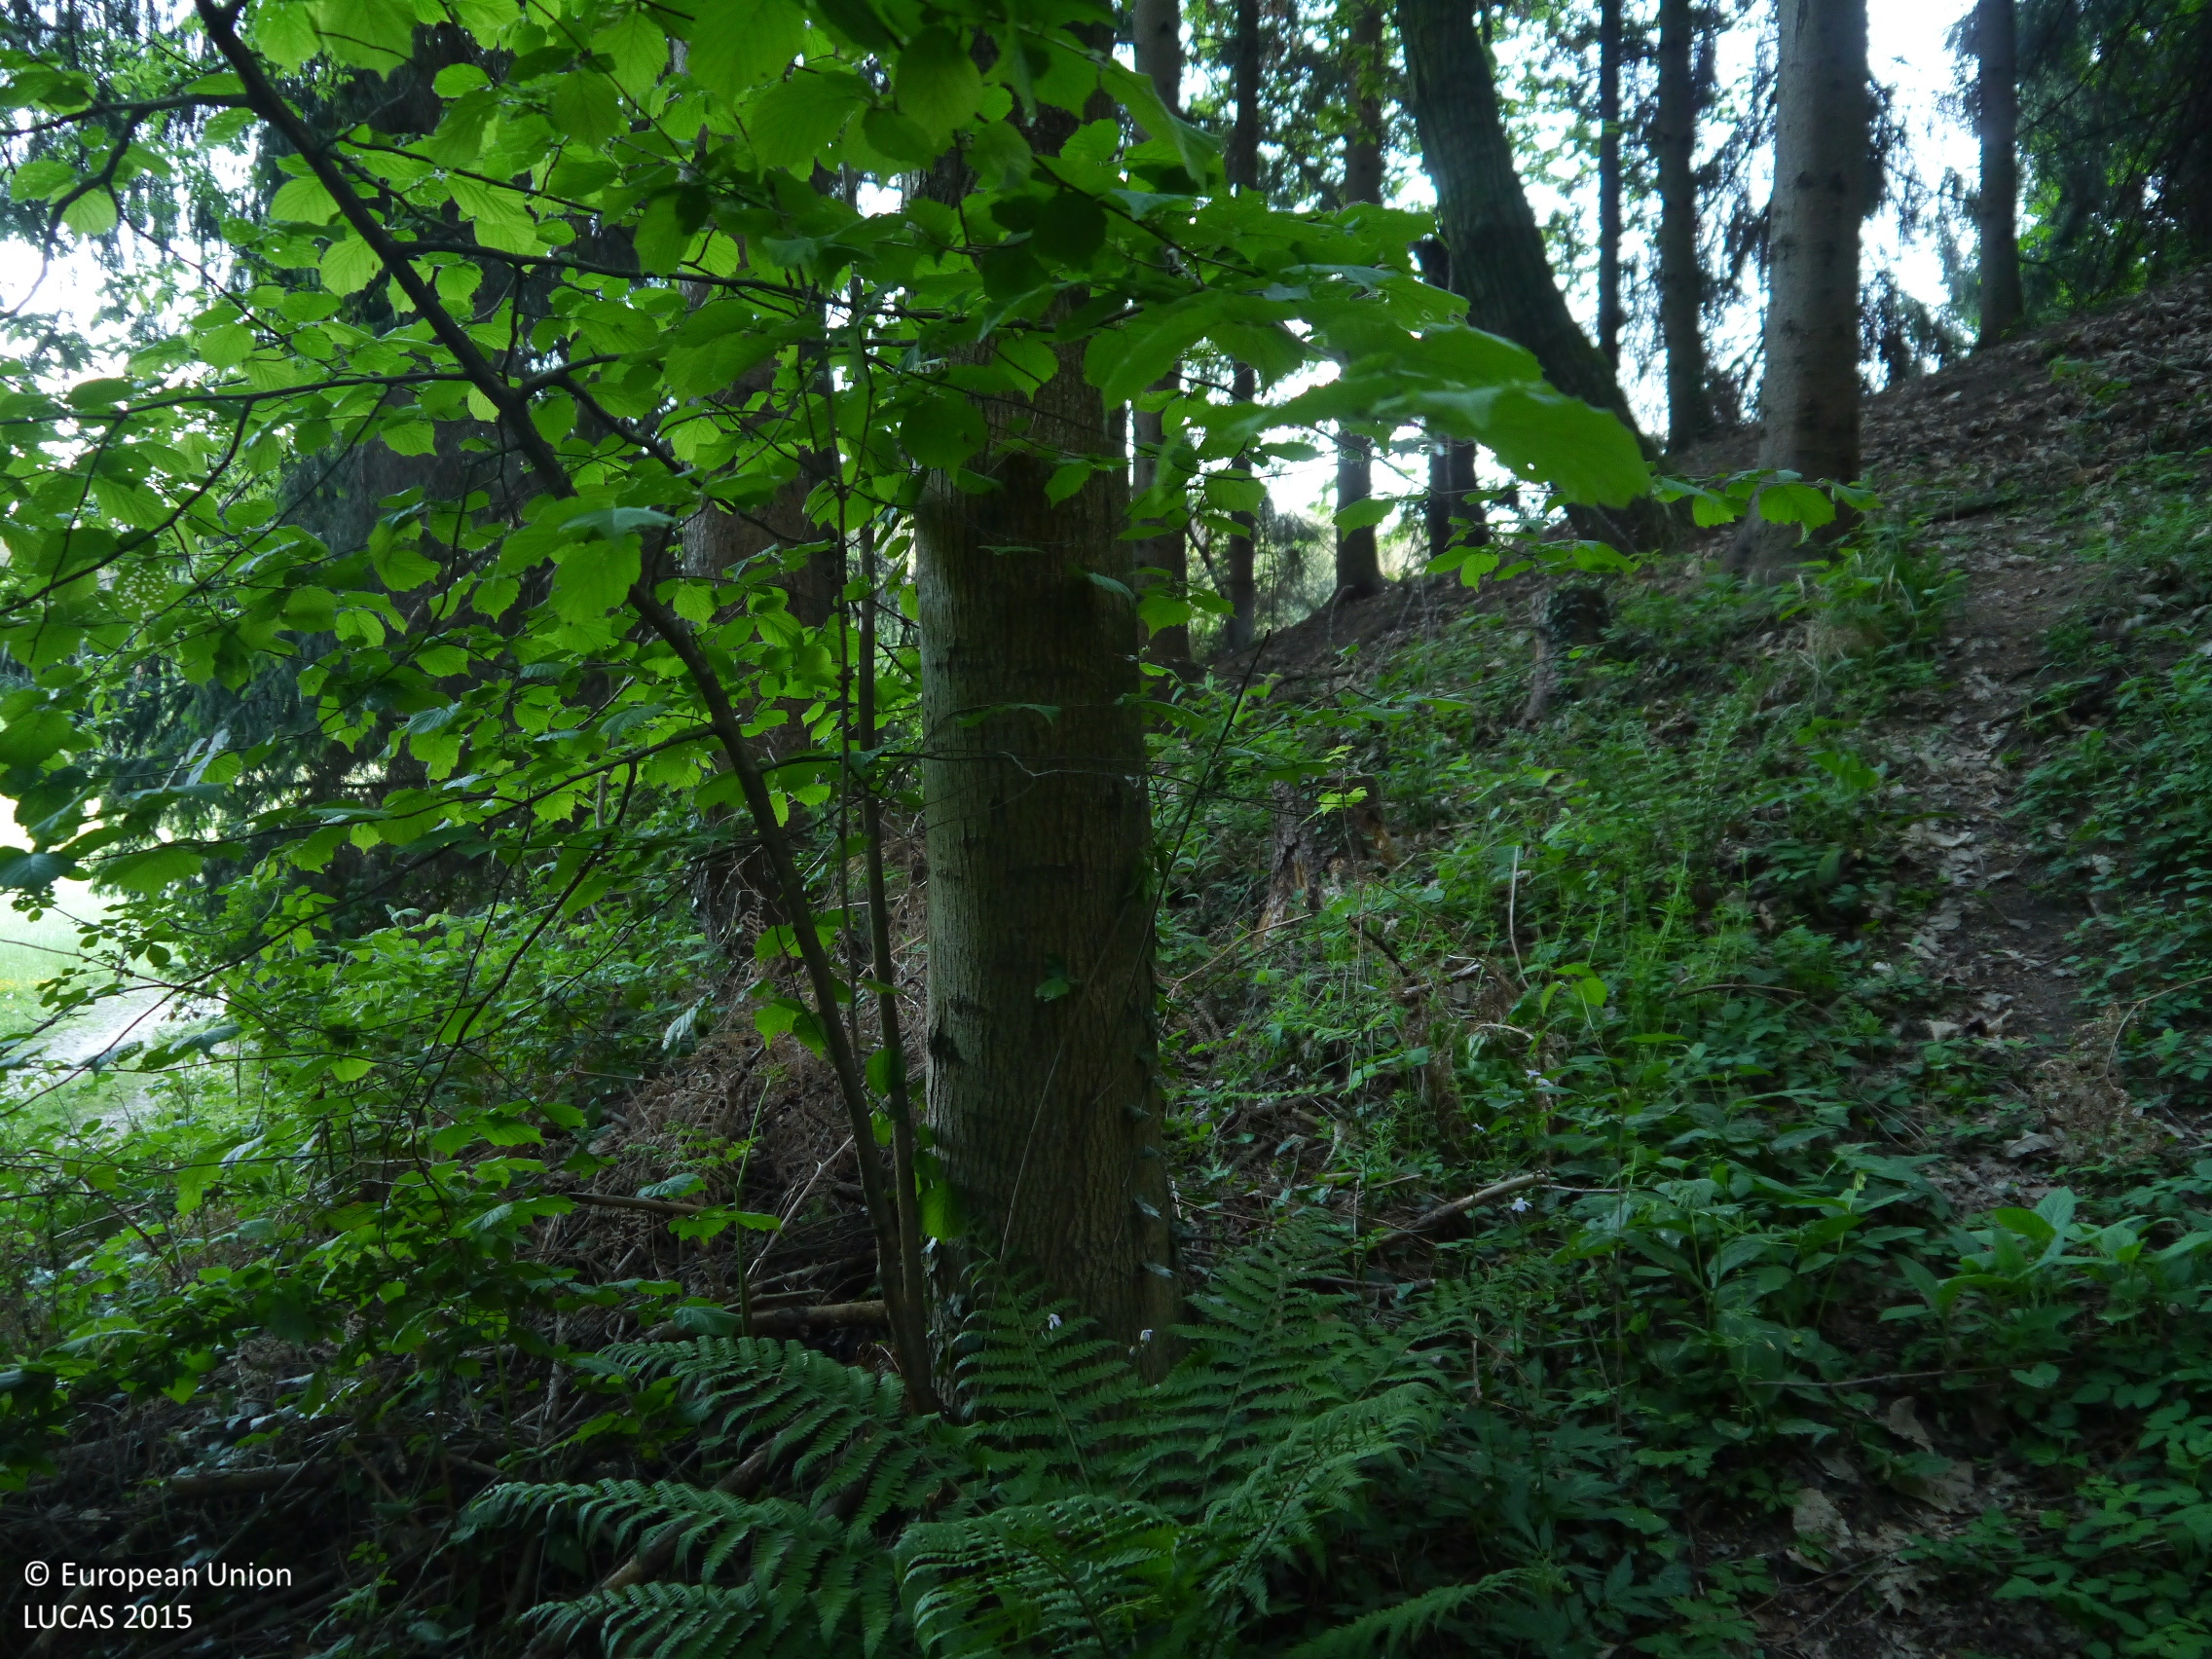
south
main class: Woodland
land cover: Spruce dominated coniferous woodland
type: hemiboreal forest and nemoral coniferous forest and mixed broadleaved-coniferous forest
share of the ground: > 75 %
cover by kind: coniferous forest trees 75 %, broadleaved forest trees 20 %, herbaceous plants 5 %
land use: Forestry
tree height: > 5 m
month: May
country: AT
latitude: 47.0843
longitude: 15.3343
